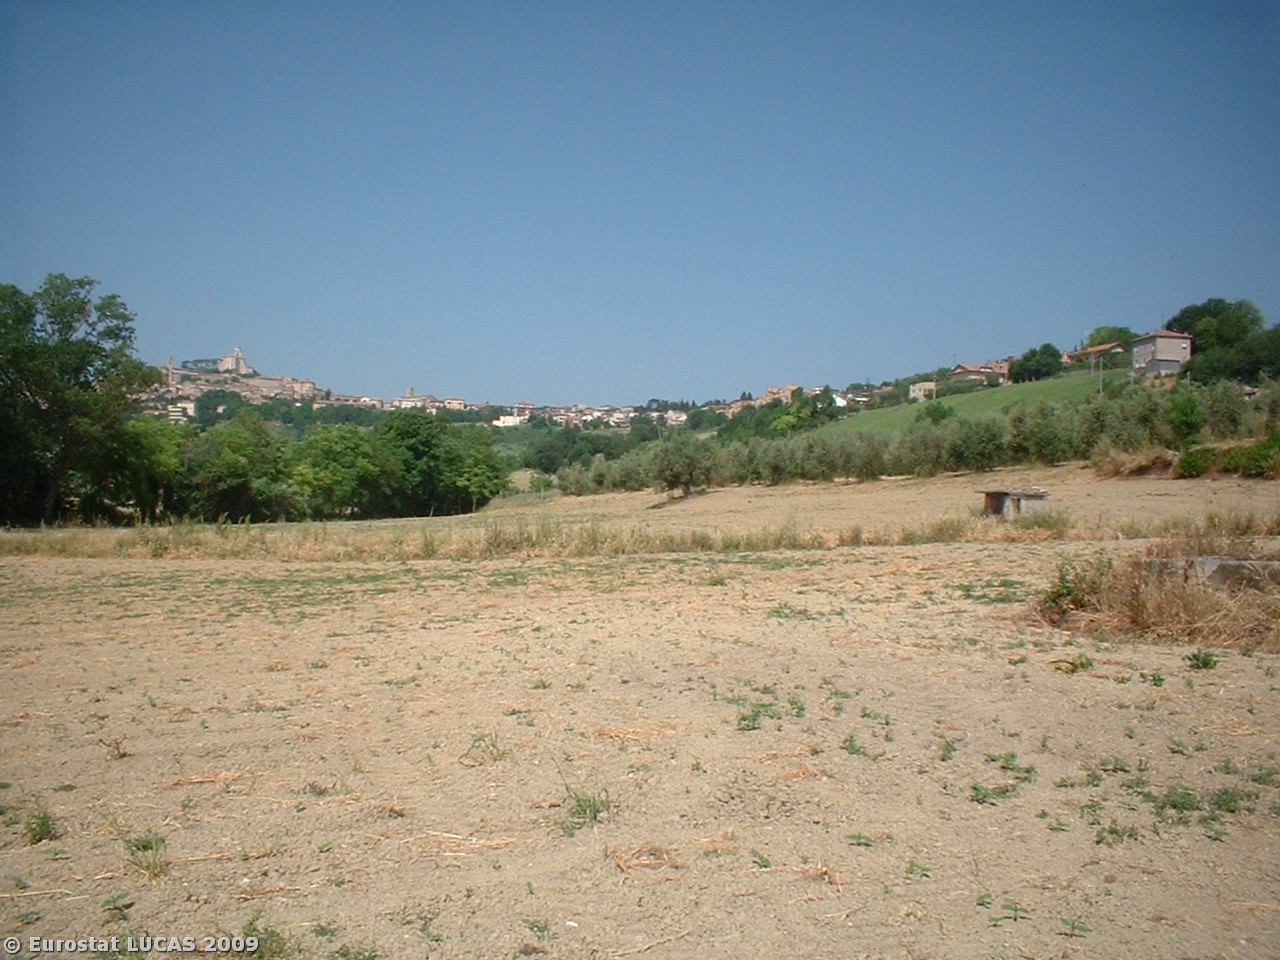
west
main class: Cropland
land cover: Sunflower
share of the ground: < 10 %
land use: Agriculture (excluding fallow land and kitchen gardens)
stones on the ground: < 10 %
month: May
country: IT
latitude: 43.1633
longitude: 13.7416
